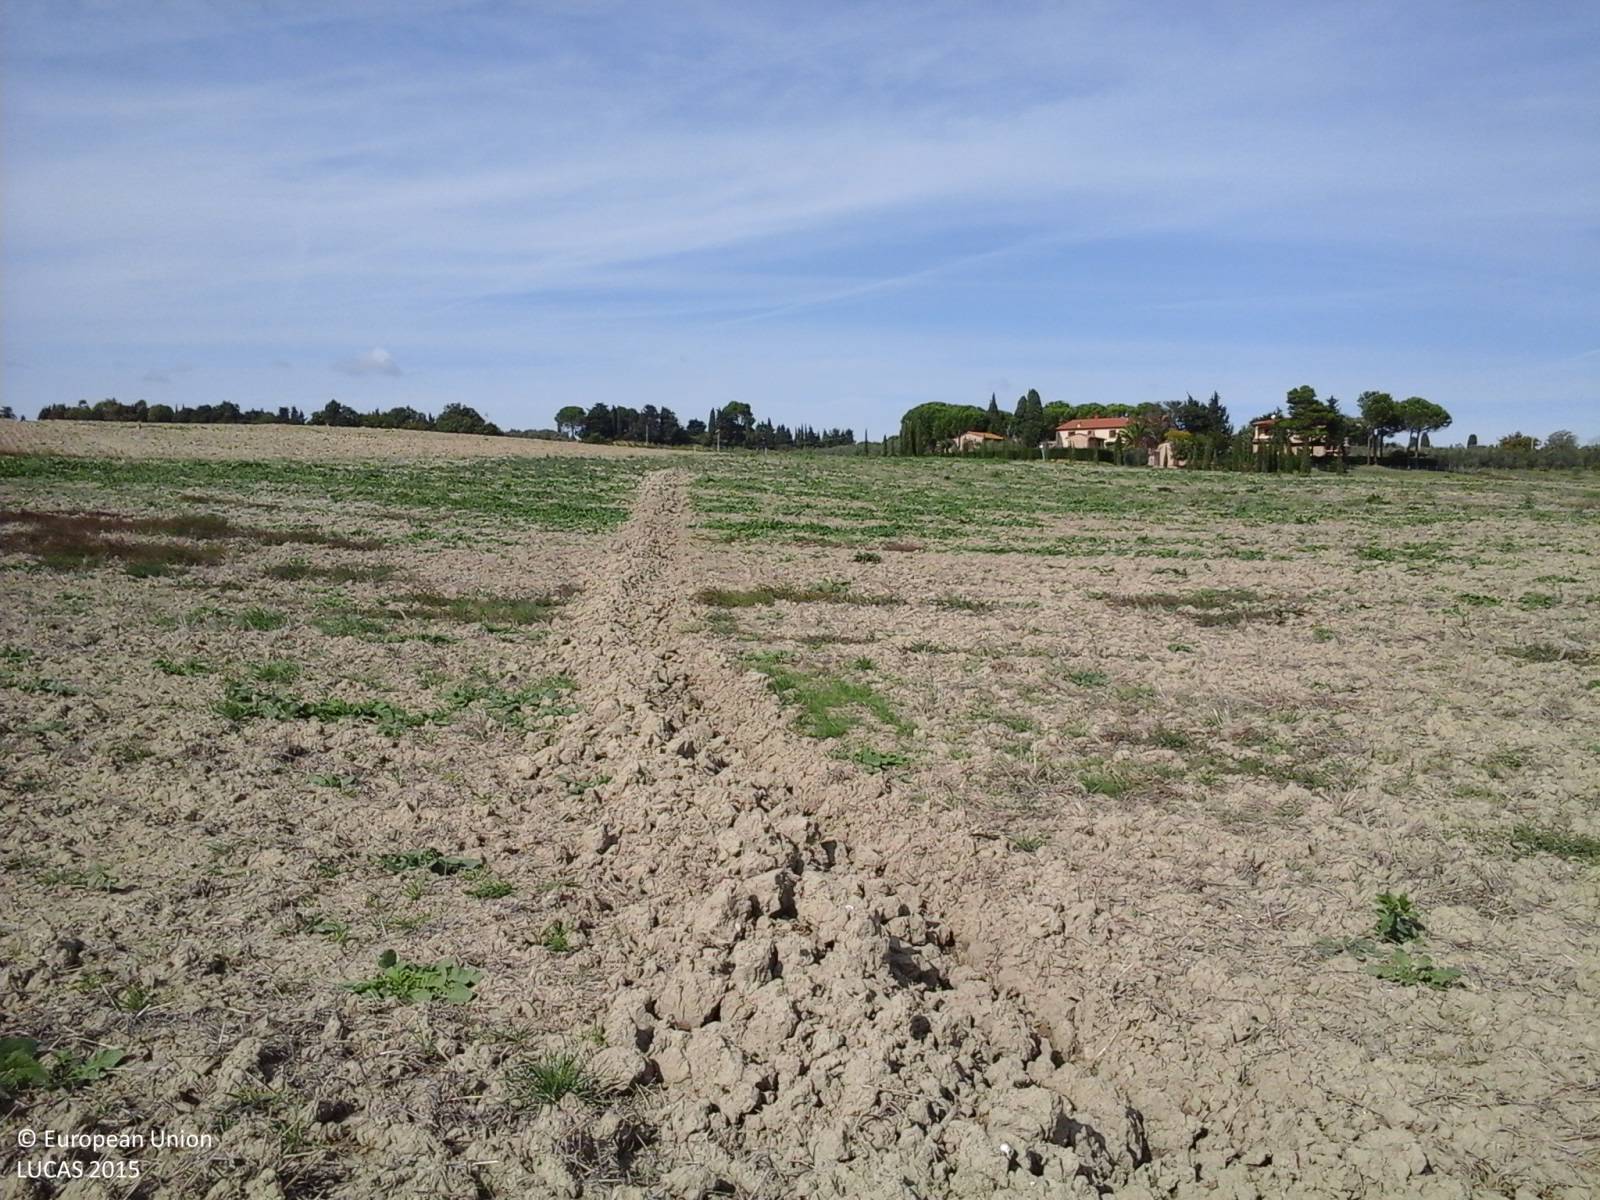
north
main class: Cropland
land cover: Durum wheat
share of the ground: < 10 %
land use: Agriculture (excluding fallow land and kitchen gardens)
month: October
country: IT
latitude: 43.2842
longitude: 10.6021
